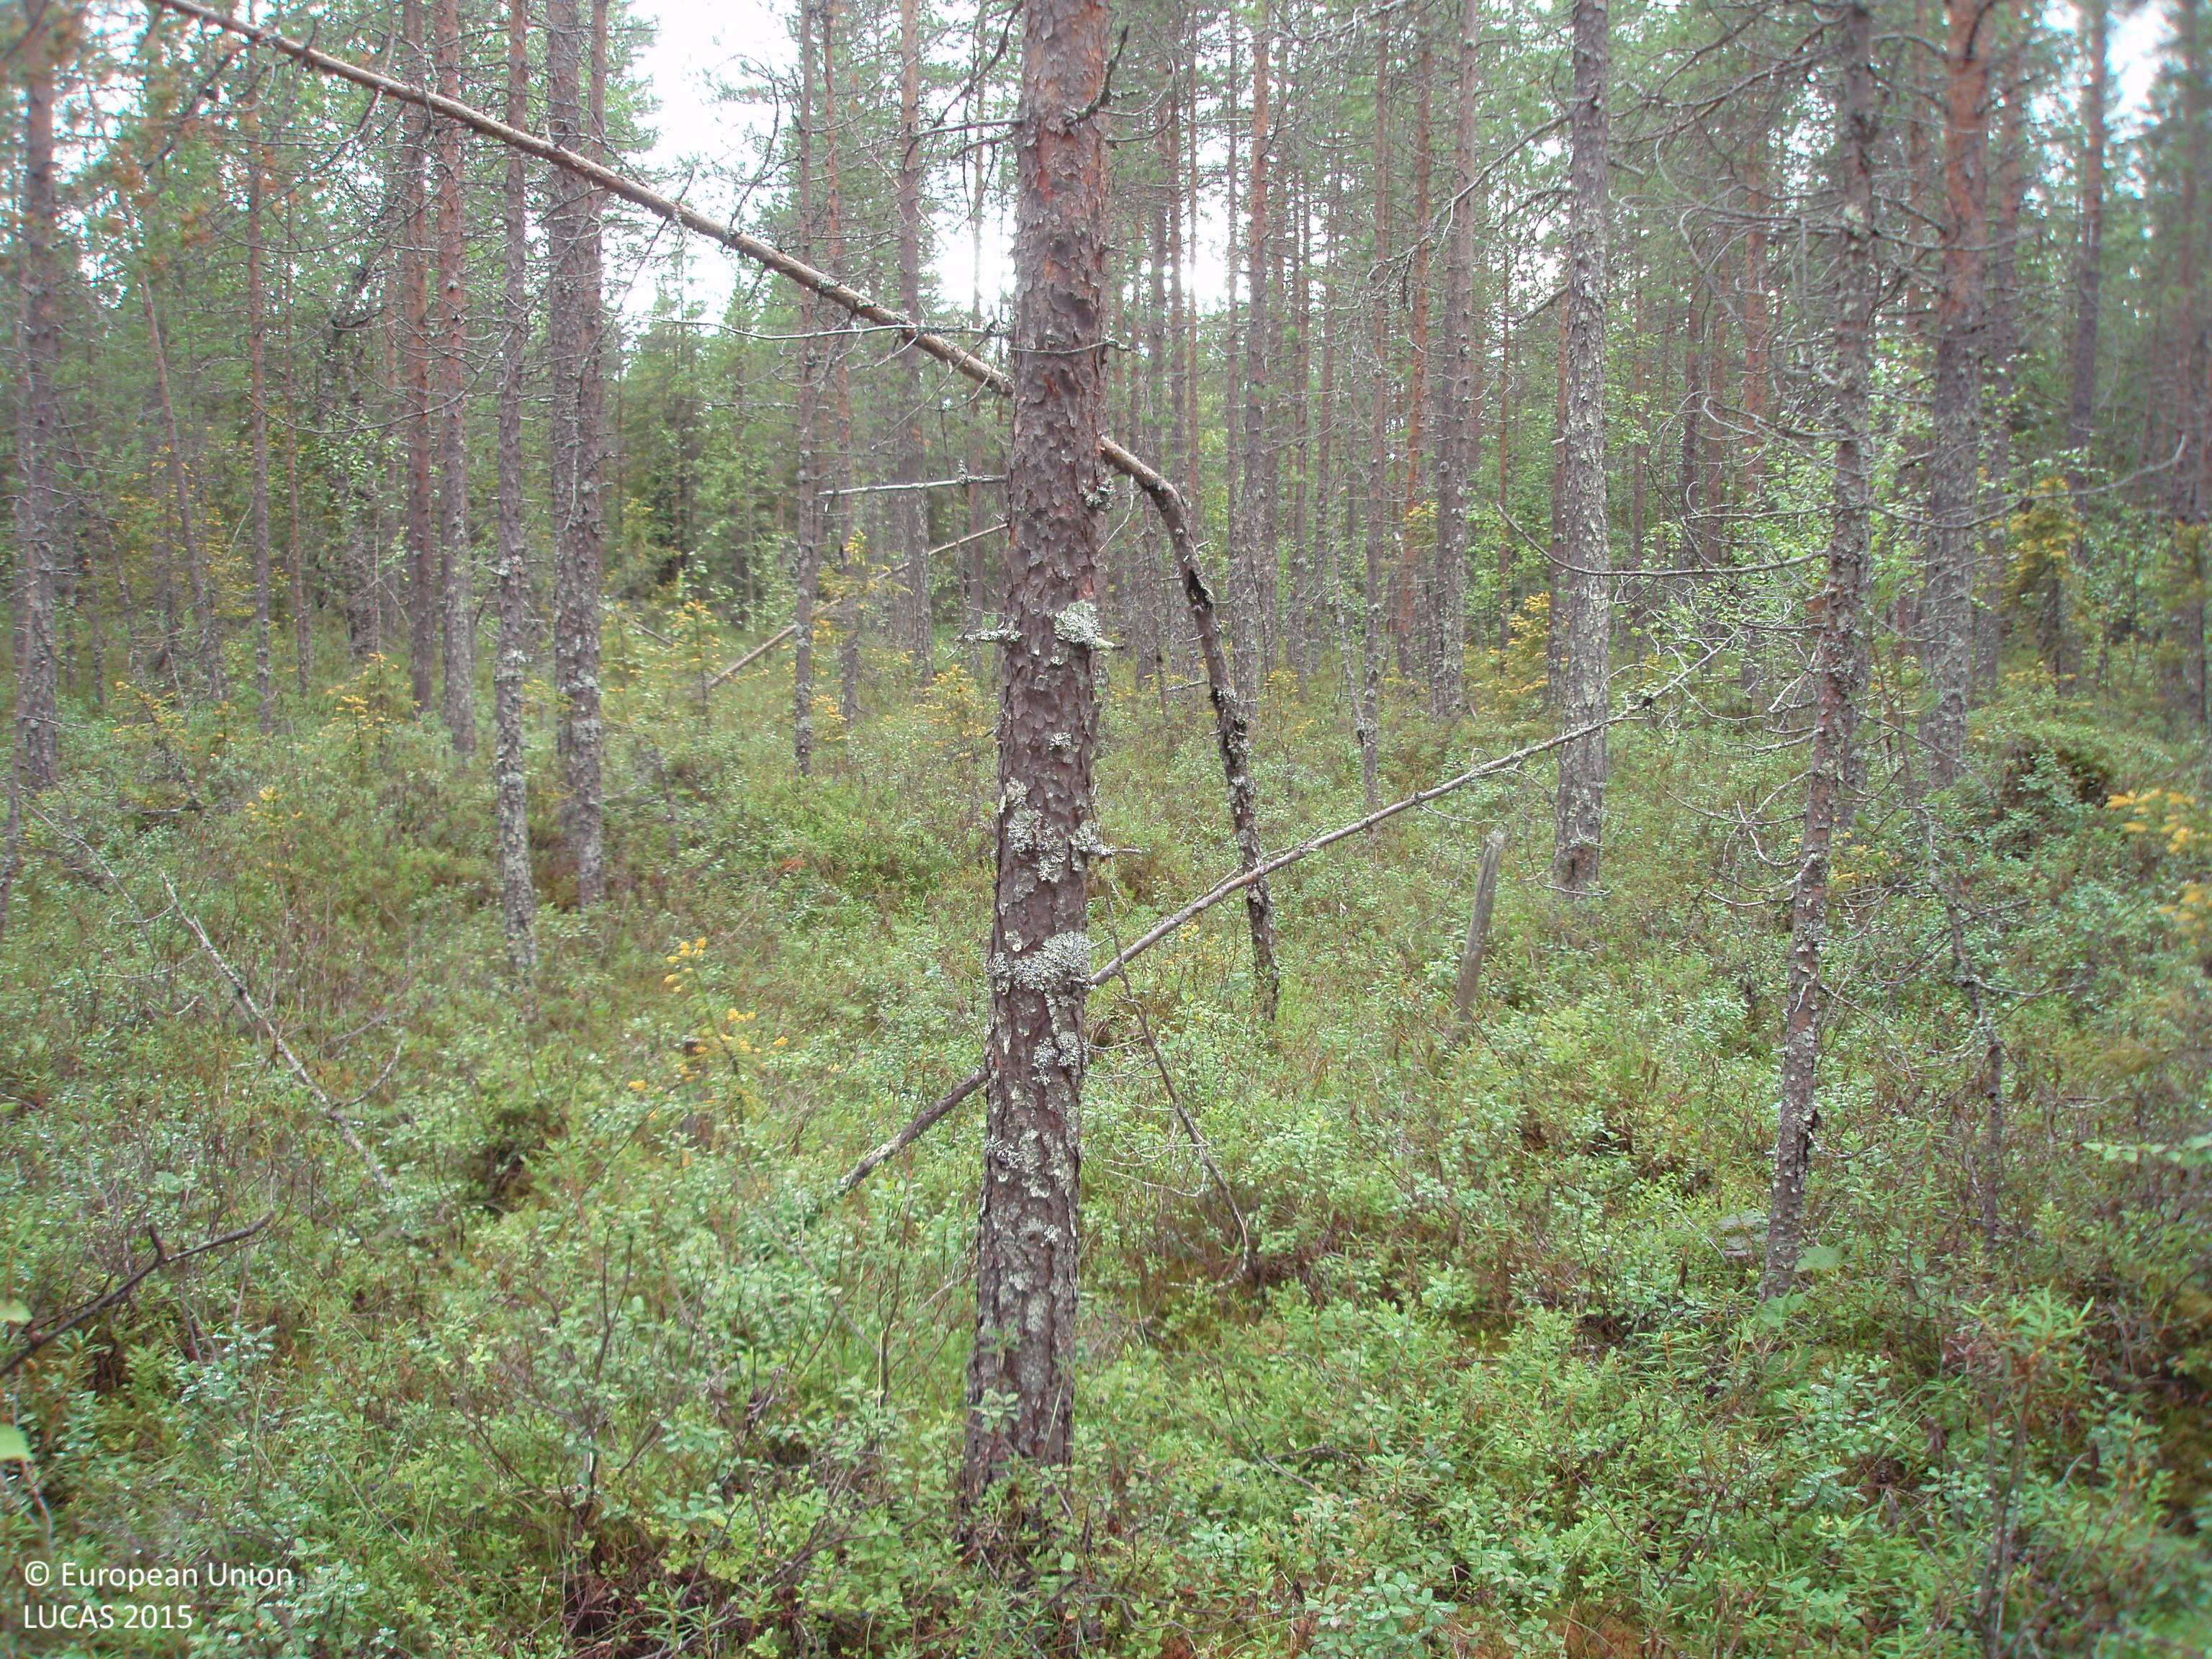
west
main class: Woodland
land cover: Pine dominated coniferous woodland
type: boreal forest
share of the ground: 50 - 75 %
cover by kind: coniferous forest trees 70 %, shrubs 25 %, lichens and mosses 5 %
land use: Forestry
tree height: > 5 m
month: August
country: FI
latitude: 65.5799
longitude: 27.2682
